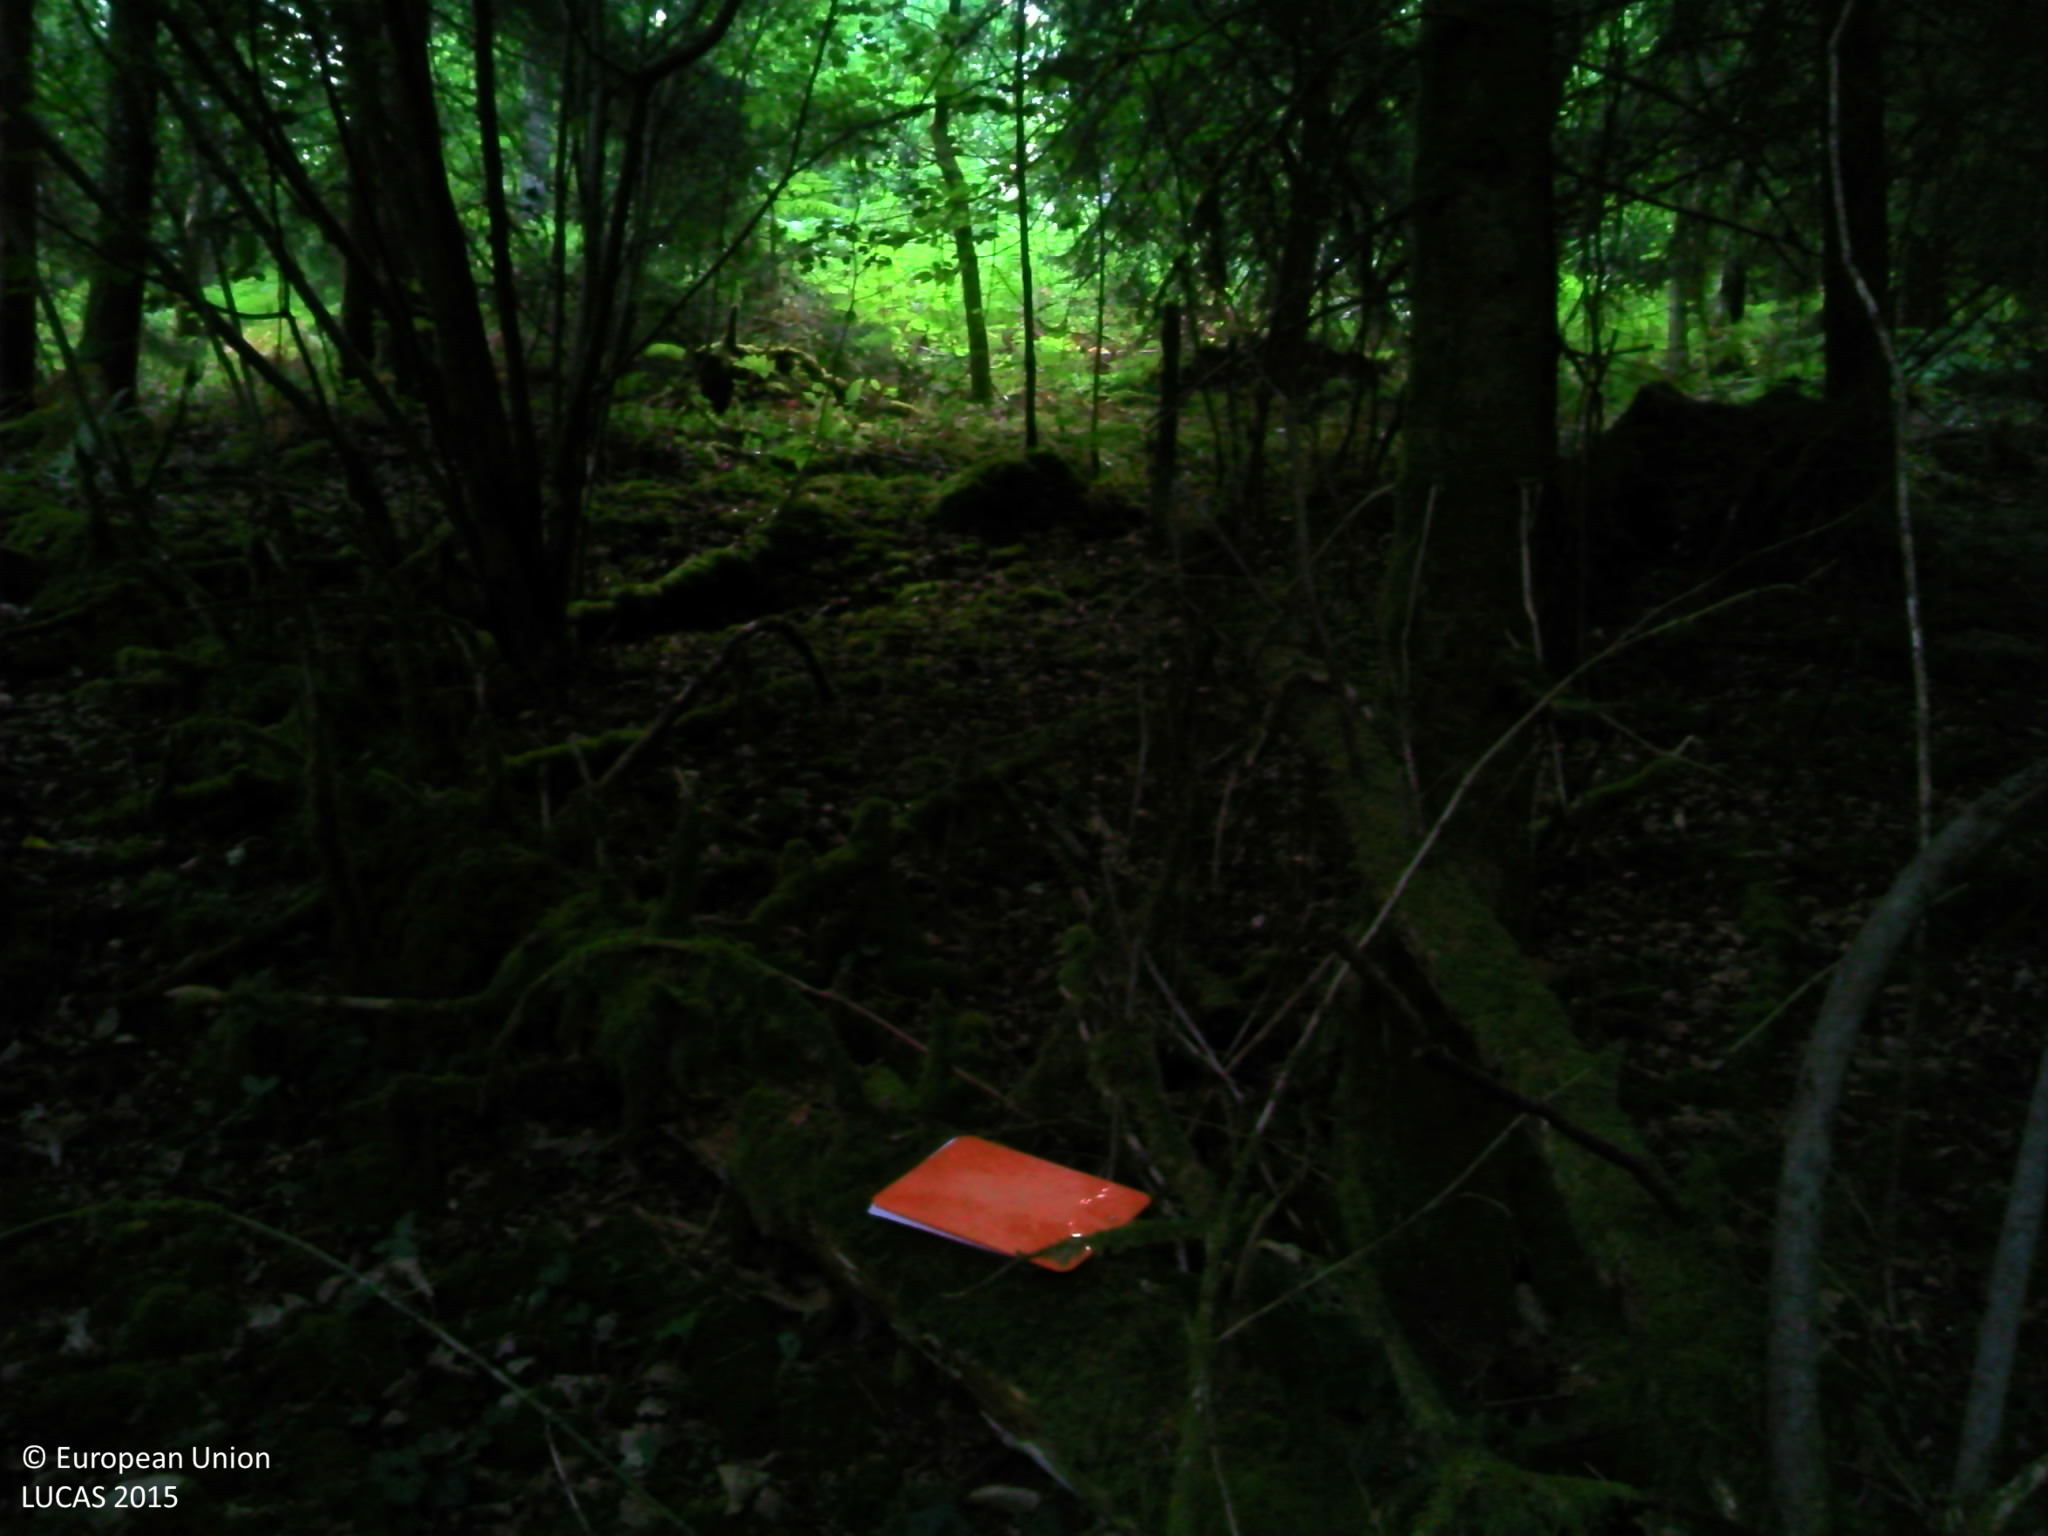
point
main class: Woodland
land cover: Spruce dominated mixed woodland
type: acidophilous oak and oak-birch forest
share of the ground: > 75 %
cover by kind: broadleaved forest trees 50 %, coniferous forest trees 30 %, unconsolidated bare surface 10 %, herbaceous plants 5 %, lichens and mosses 5 %
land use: Forestry
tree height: > 5 m
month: July
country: FR
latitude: 45.6671
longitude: 0.6300
